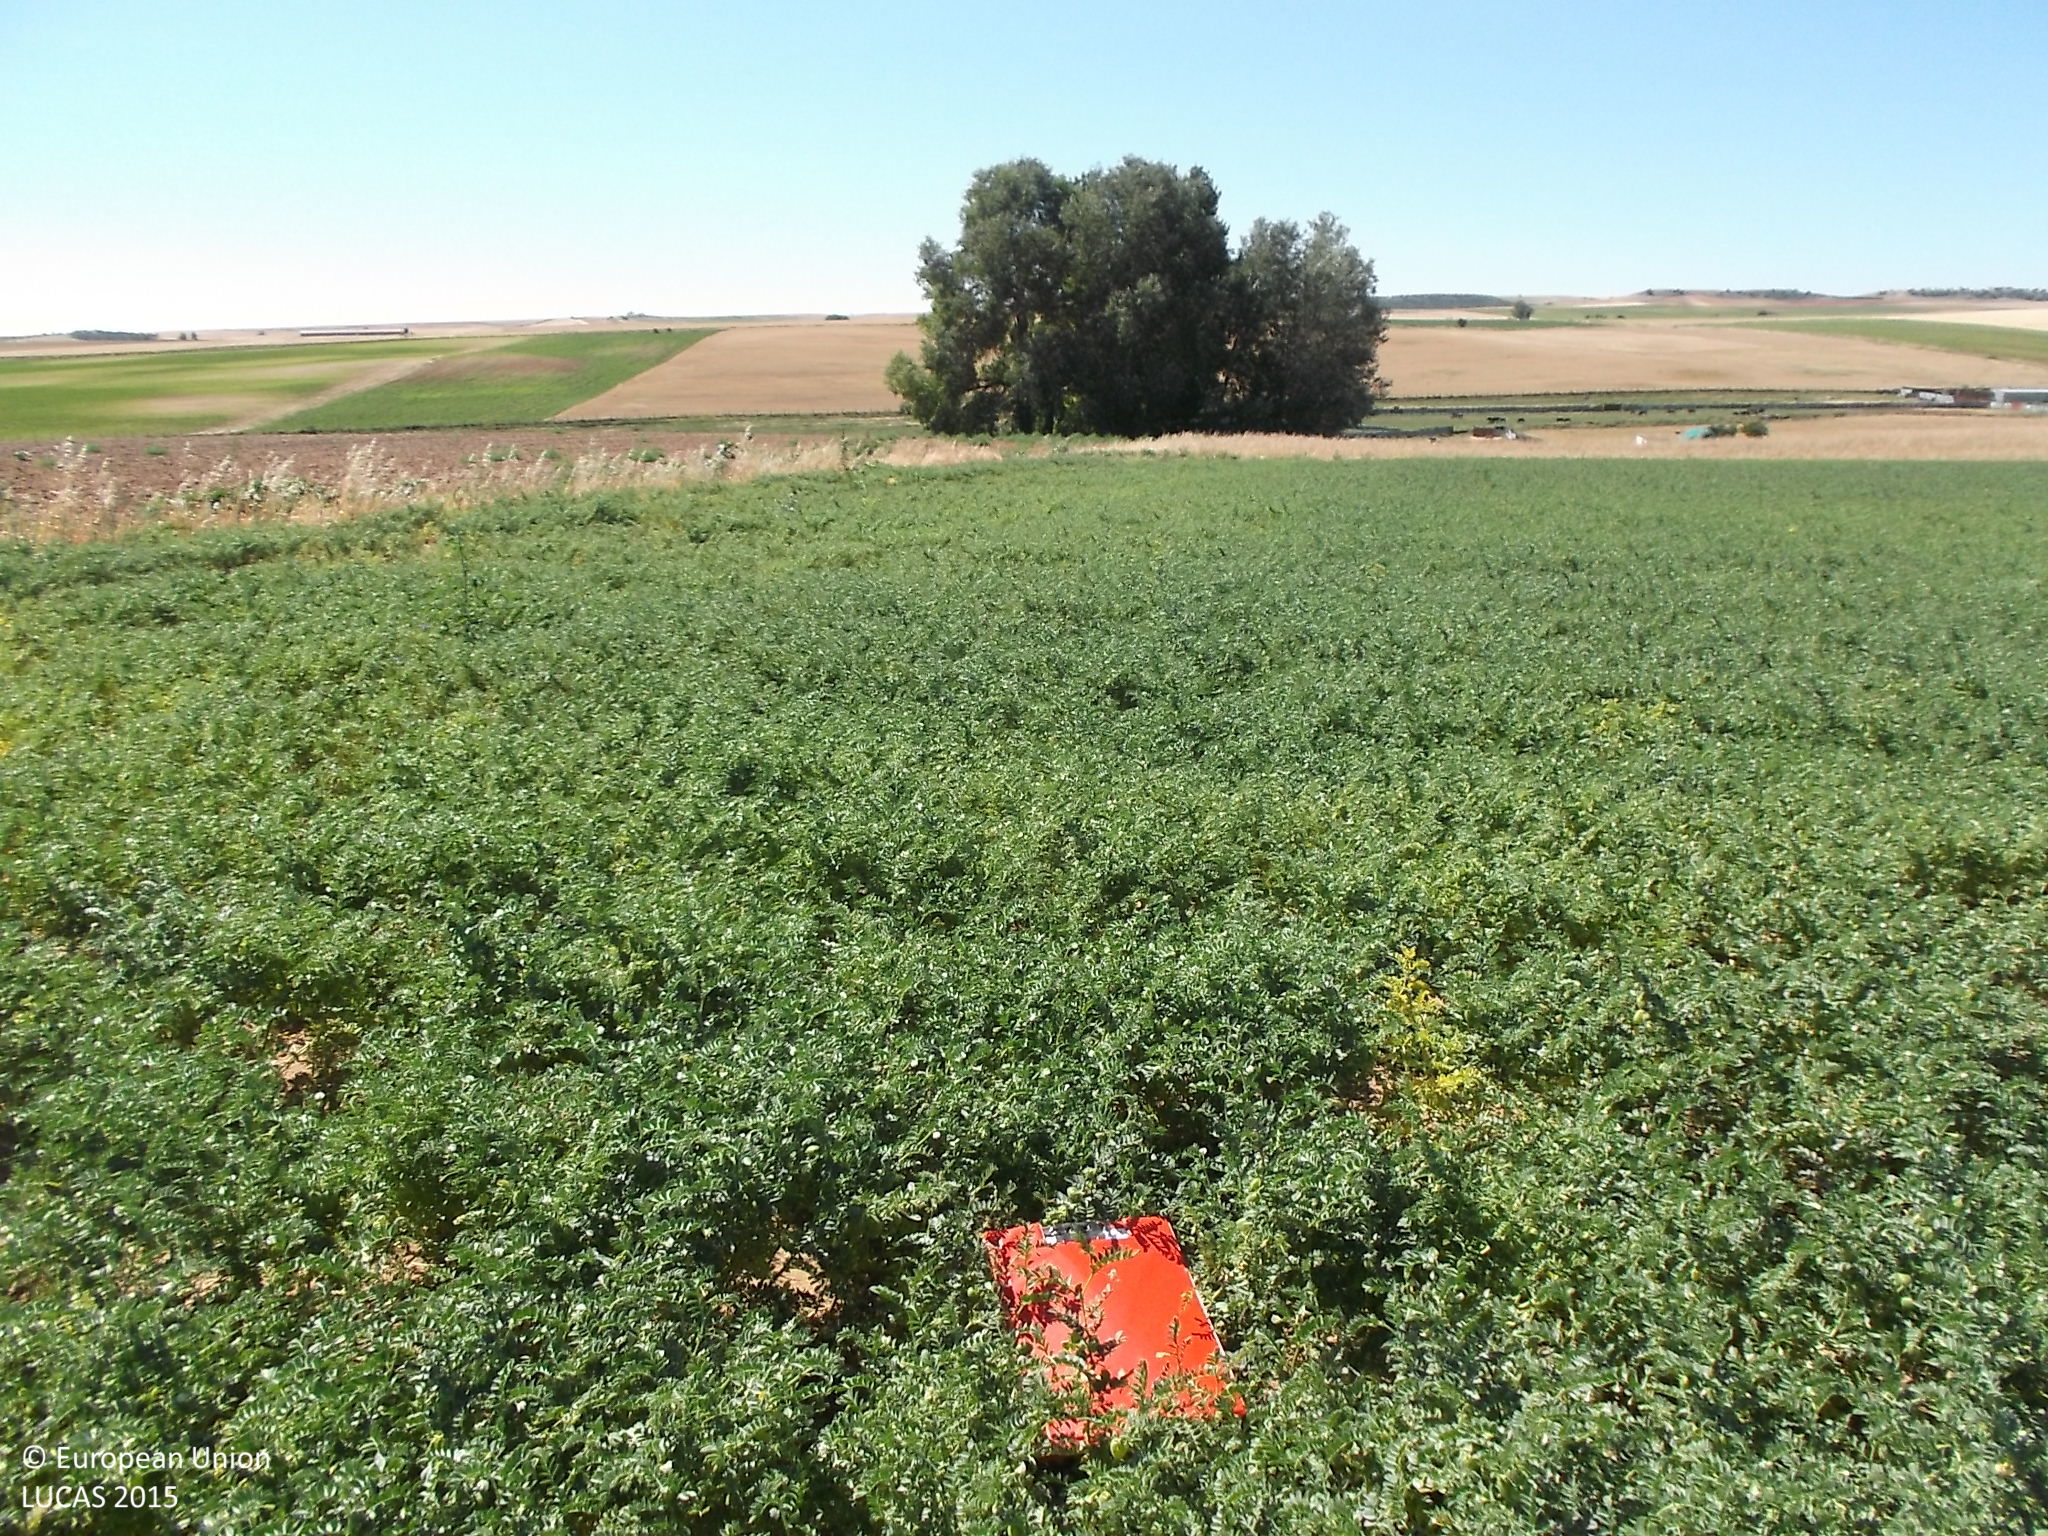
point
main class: Cropland
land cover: Dry pulses
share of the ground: > 75 %
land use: Agriculture (excluding fallow land and kitchen gardens)
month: June
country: ES
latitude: 41.2462
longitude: -5.4102
